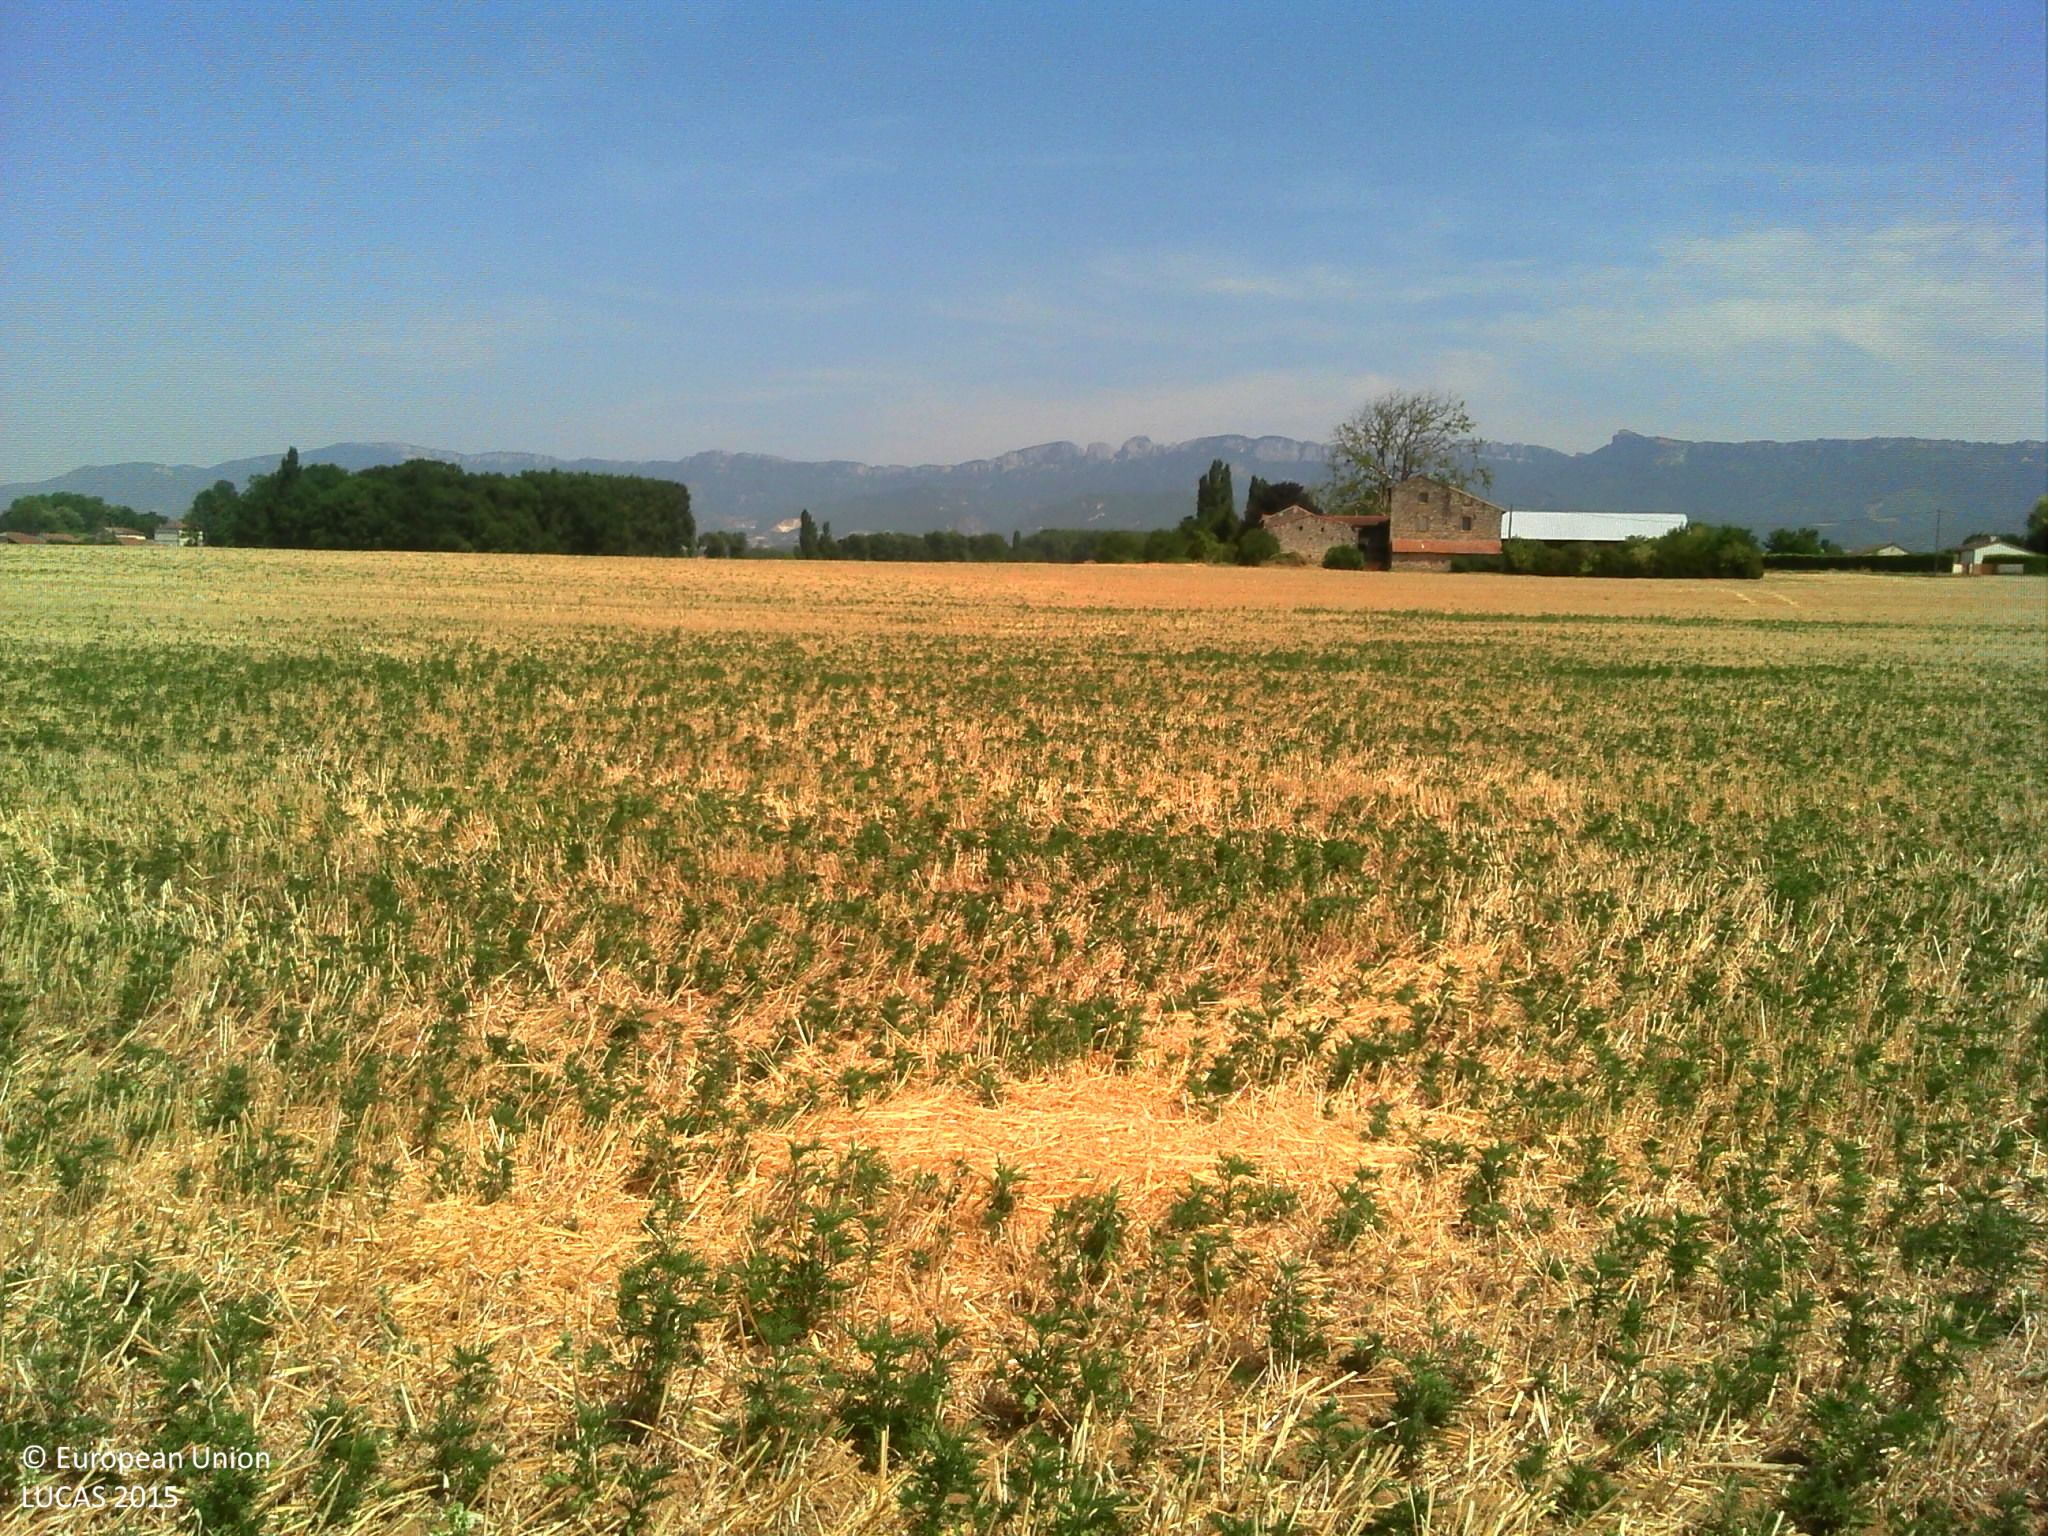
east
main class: Cropland
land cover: Barley
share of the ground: > 75 %
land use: Agriculture (excluding fallow land and kitchen gardens)
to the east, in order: Barley
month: July
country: FR
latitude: 44.9538
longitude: 5.0242
